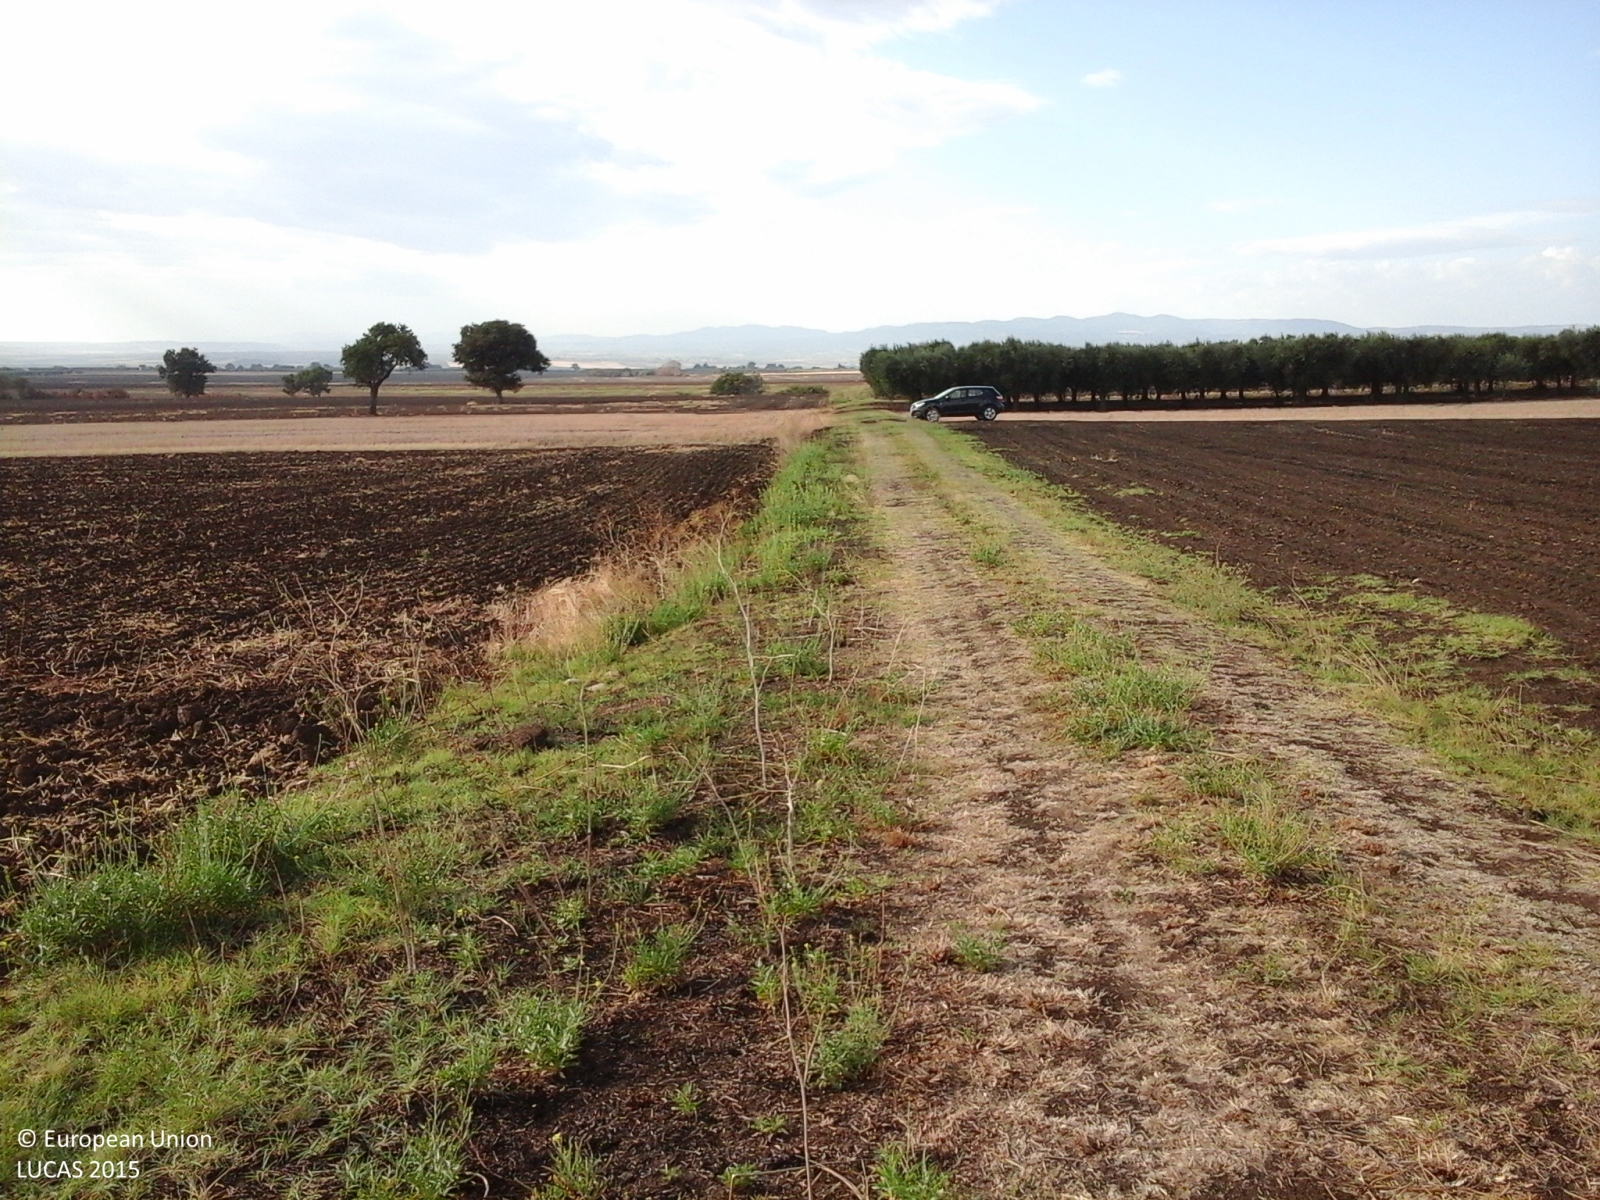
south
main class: Cropland
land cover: Durum wheat
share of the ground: > 75 %
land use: Agriculture (excluding fallow land and kitchen gardens)
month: September
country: IT
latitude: 41.7631
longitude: 15.1438
